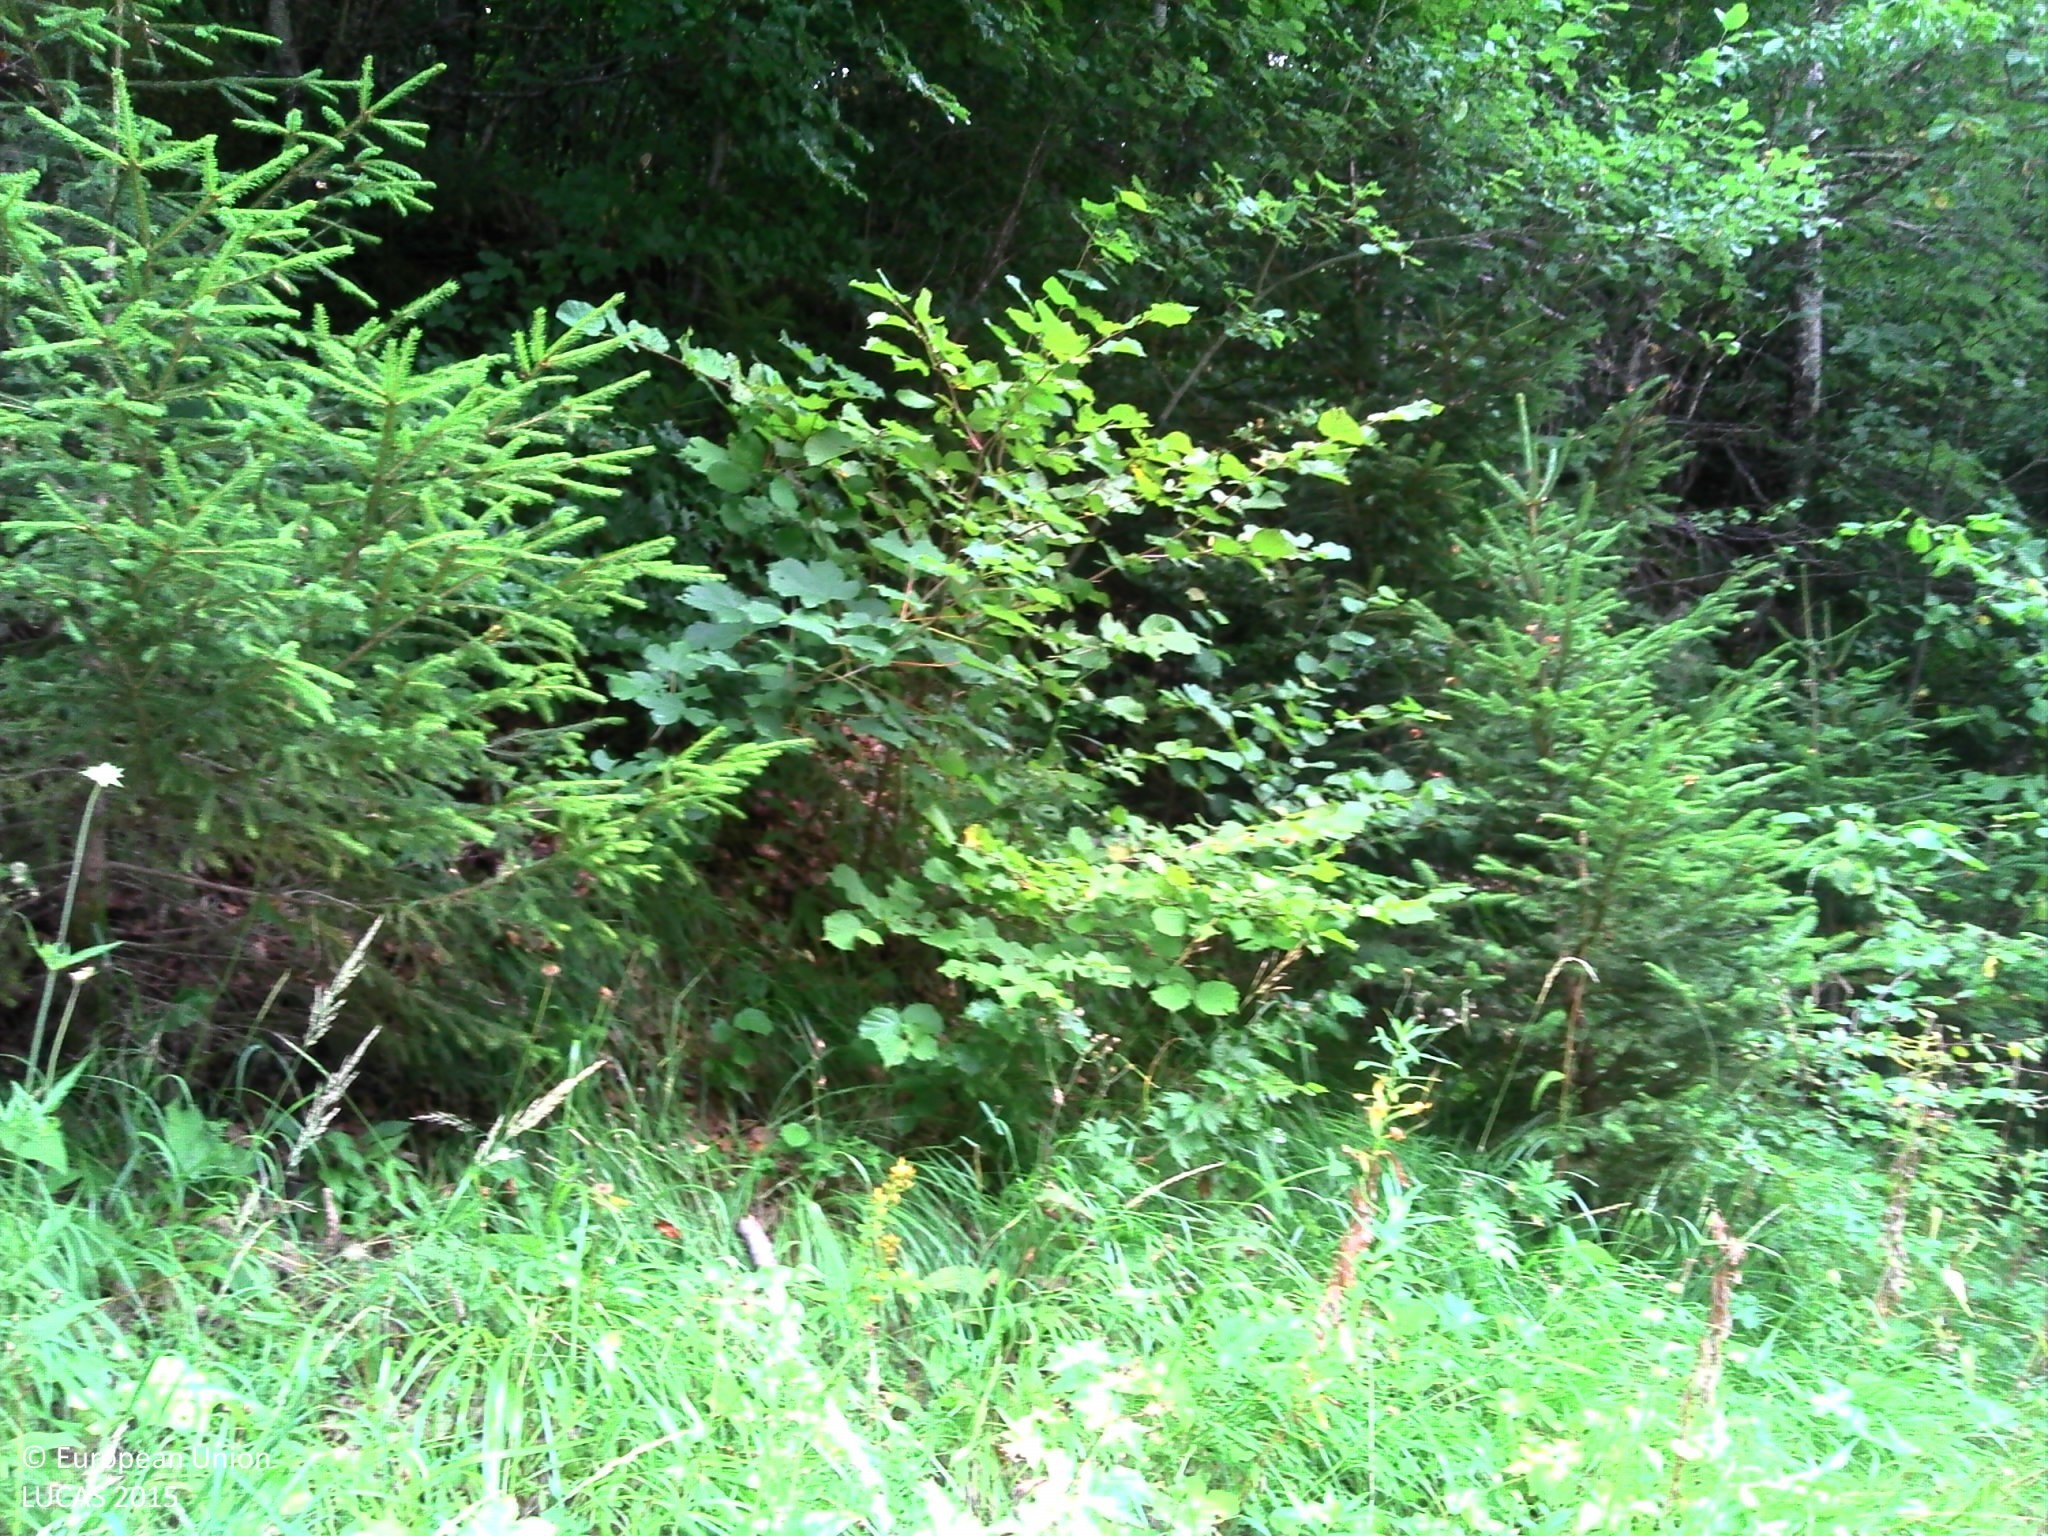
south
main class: Woodland
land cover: Other mixed woodland
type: alpine coniferous forest
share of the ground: > 75 %
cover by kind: coniferous forest trees 55 %, broadleaved forest trees 40 %, unconsolidated bare surface 5 %
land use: Semi-natural and natural areas not in use
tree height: > 5 m
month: July
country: FR
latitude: 44.8517
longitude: 5.5648
